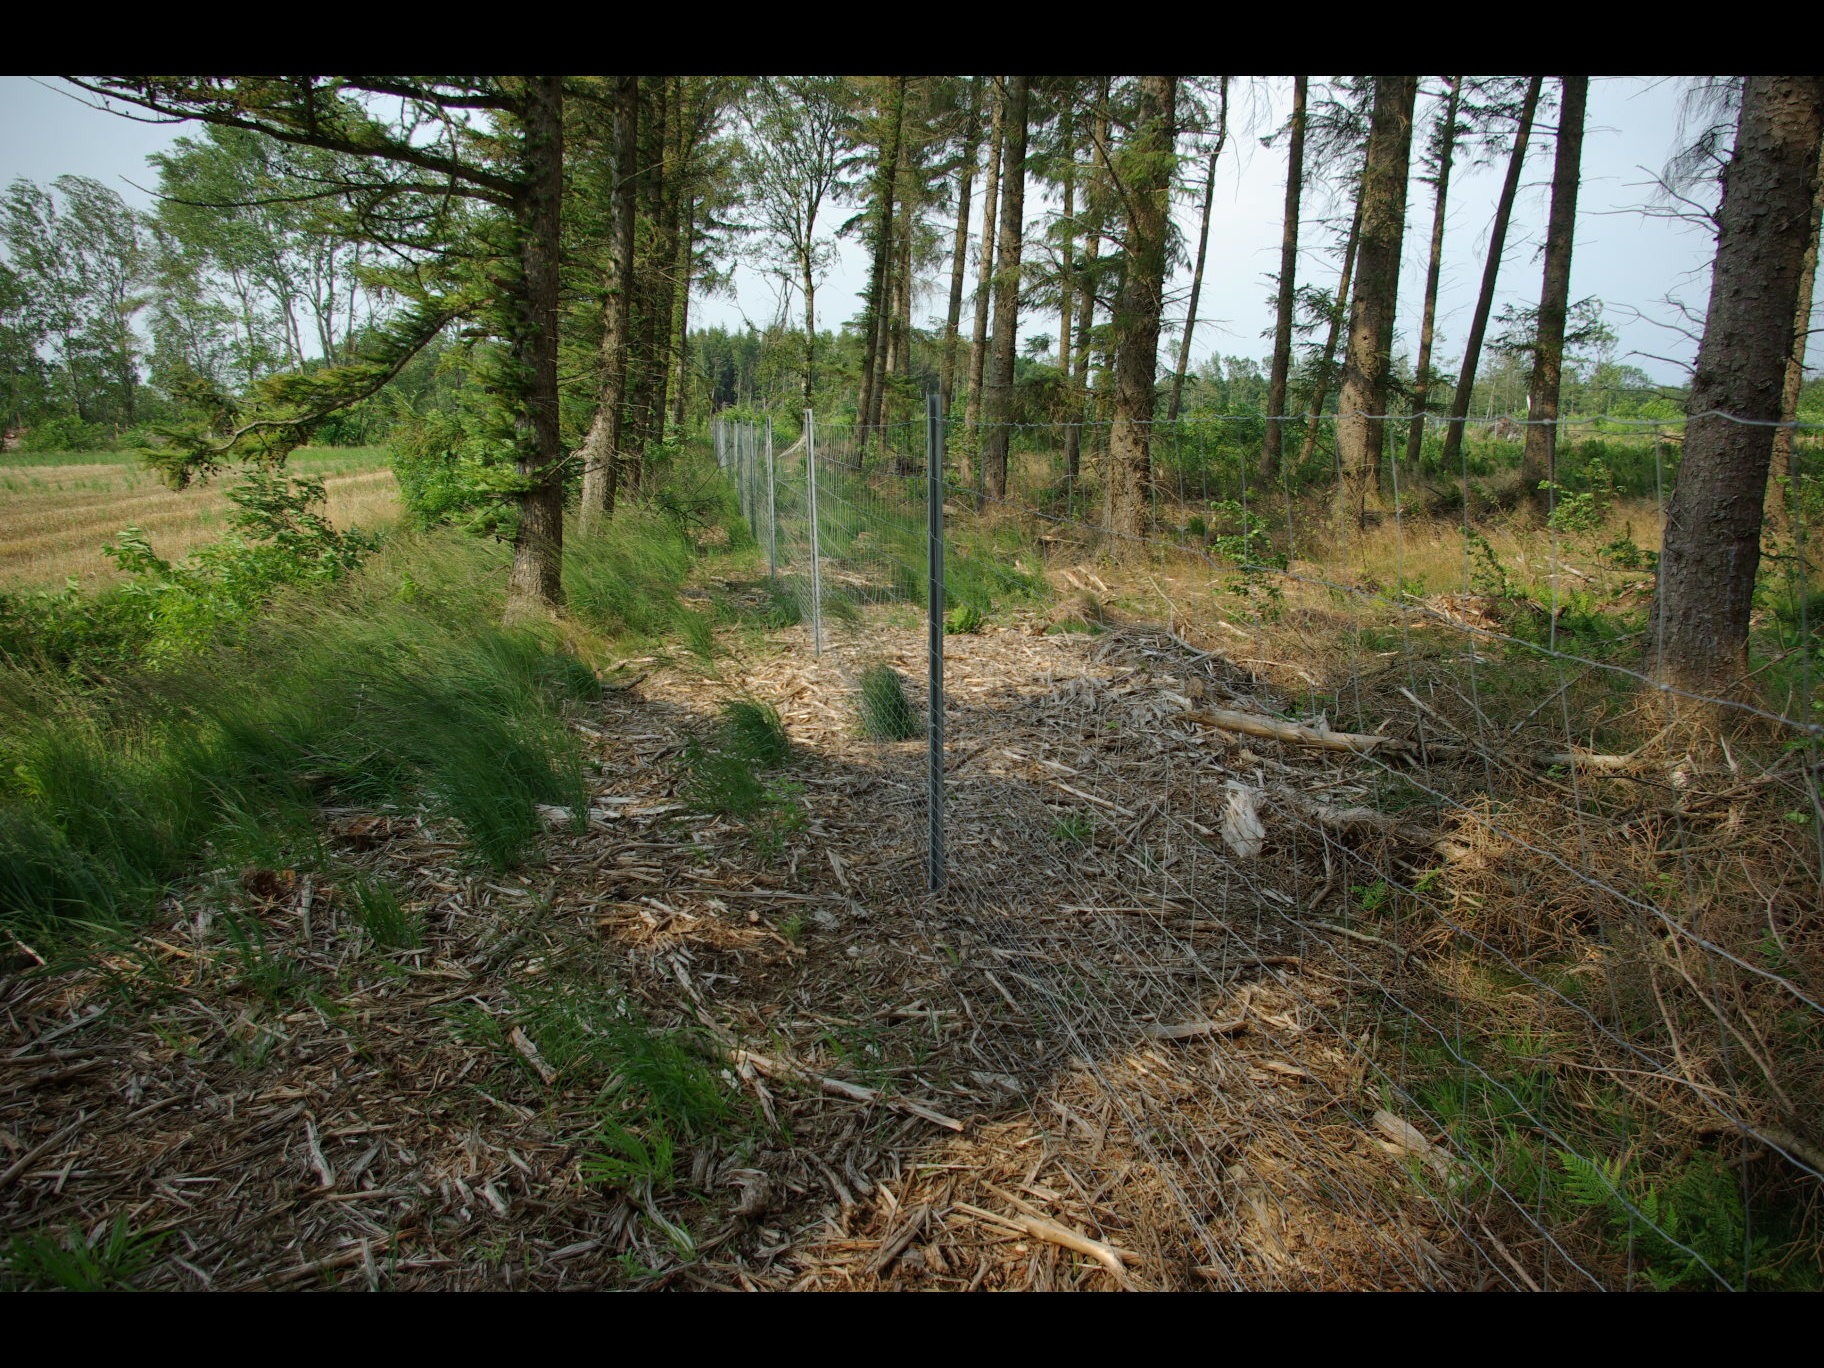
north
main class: Woodland
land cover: Spruce dominated coniferous woodland
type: hemiboreal forest and nemoral coniferous forest and mixed broadleaved-coniferous forest
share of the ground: 50 - 75 %
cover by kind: coniferous forest trees 60 %, herbaceous plants 30 %, unconsolidated bare surface 10 %
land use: Forestry
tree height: > 5 m
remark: Clear cut
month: August
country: DE
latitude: 54.5502
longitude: 9.3048
